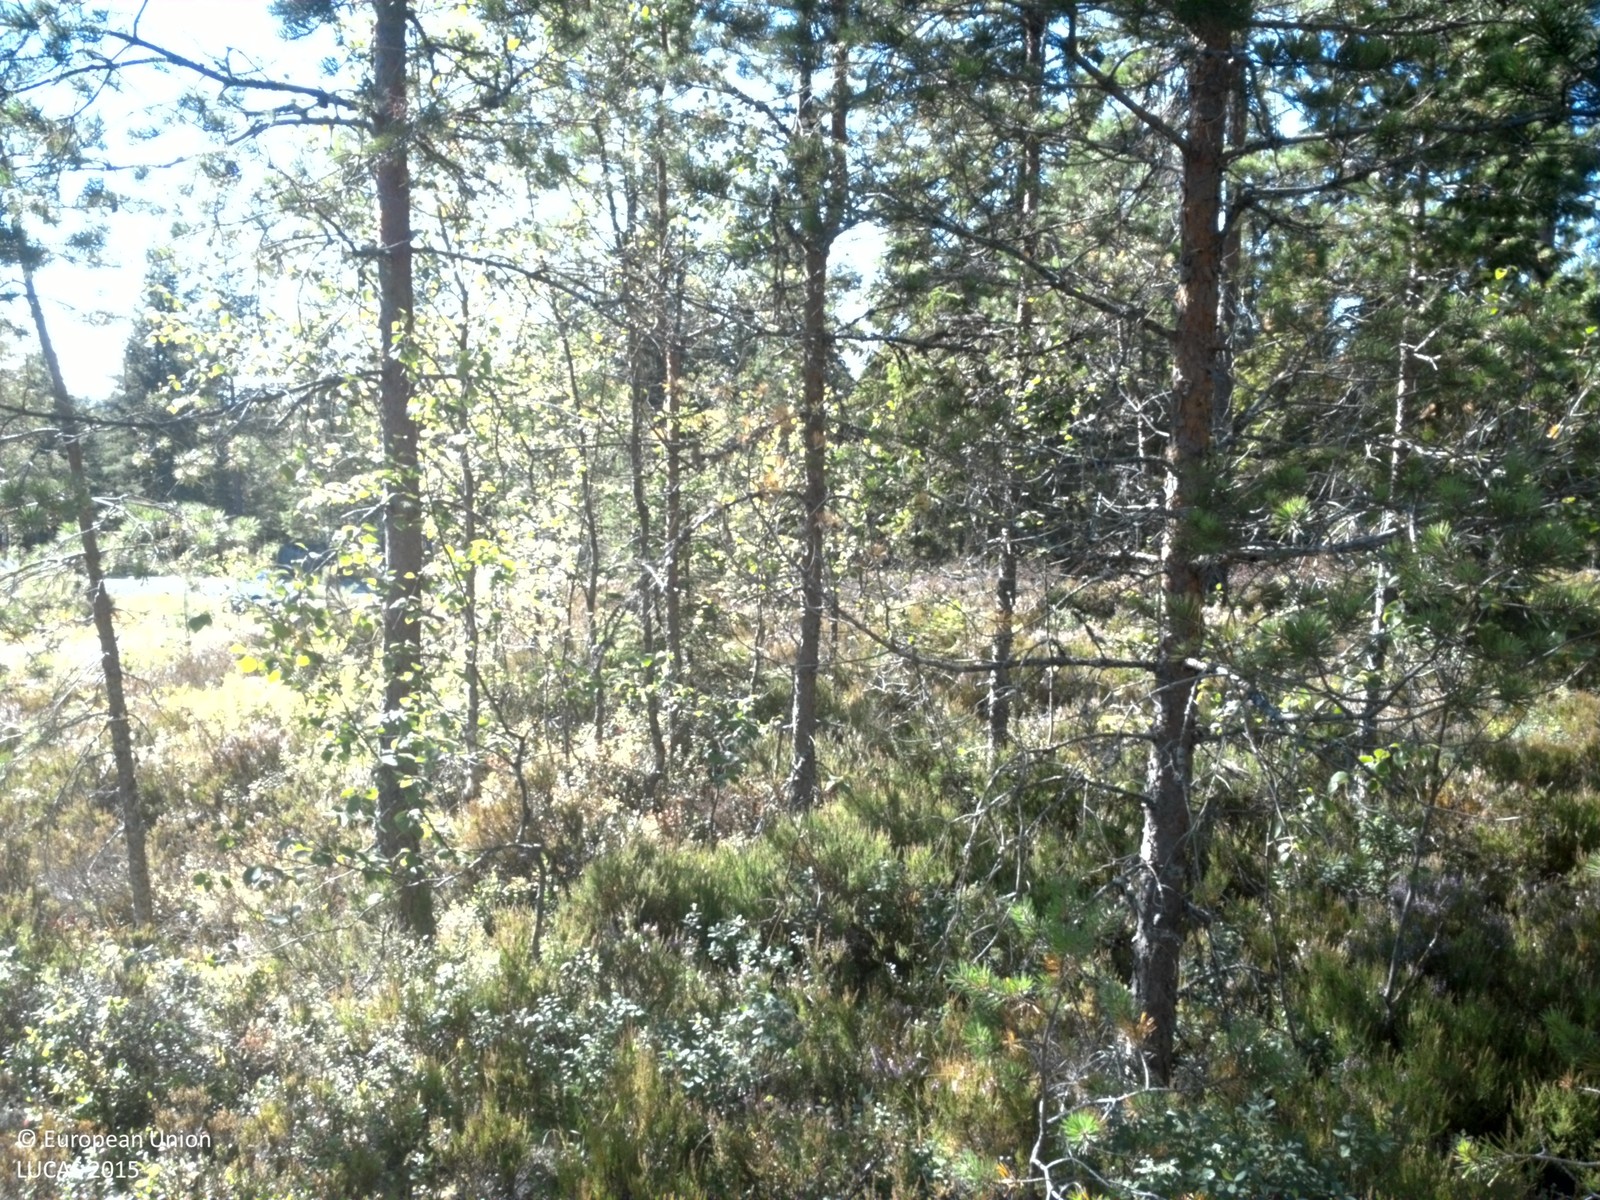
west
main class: Woodland
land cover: Other coniferous woodland
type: boreal forest
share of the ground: 50 - 75 %
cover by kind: coniferous forest trees 60 %, shrubs 30 %, broadleaved forest trees 5 %, lichens and mosses 5 %
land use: Forestry
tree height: > 5 m
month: August
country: SE
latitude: 59.9391
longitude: 14.1601
